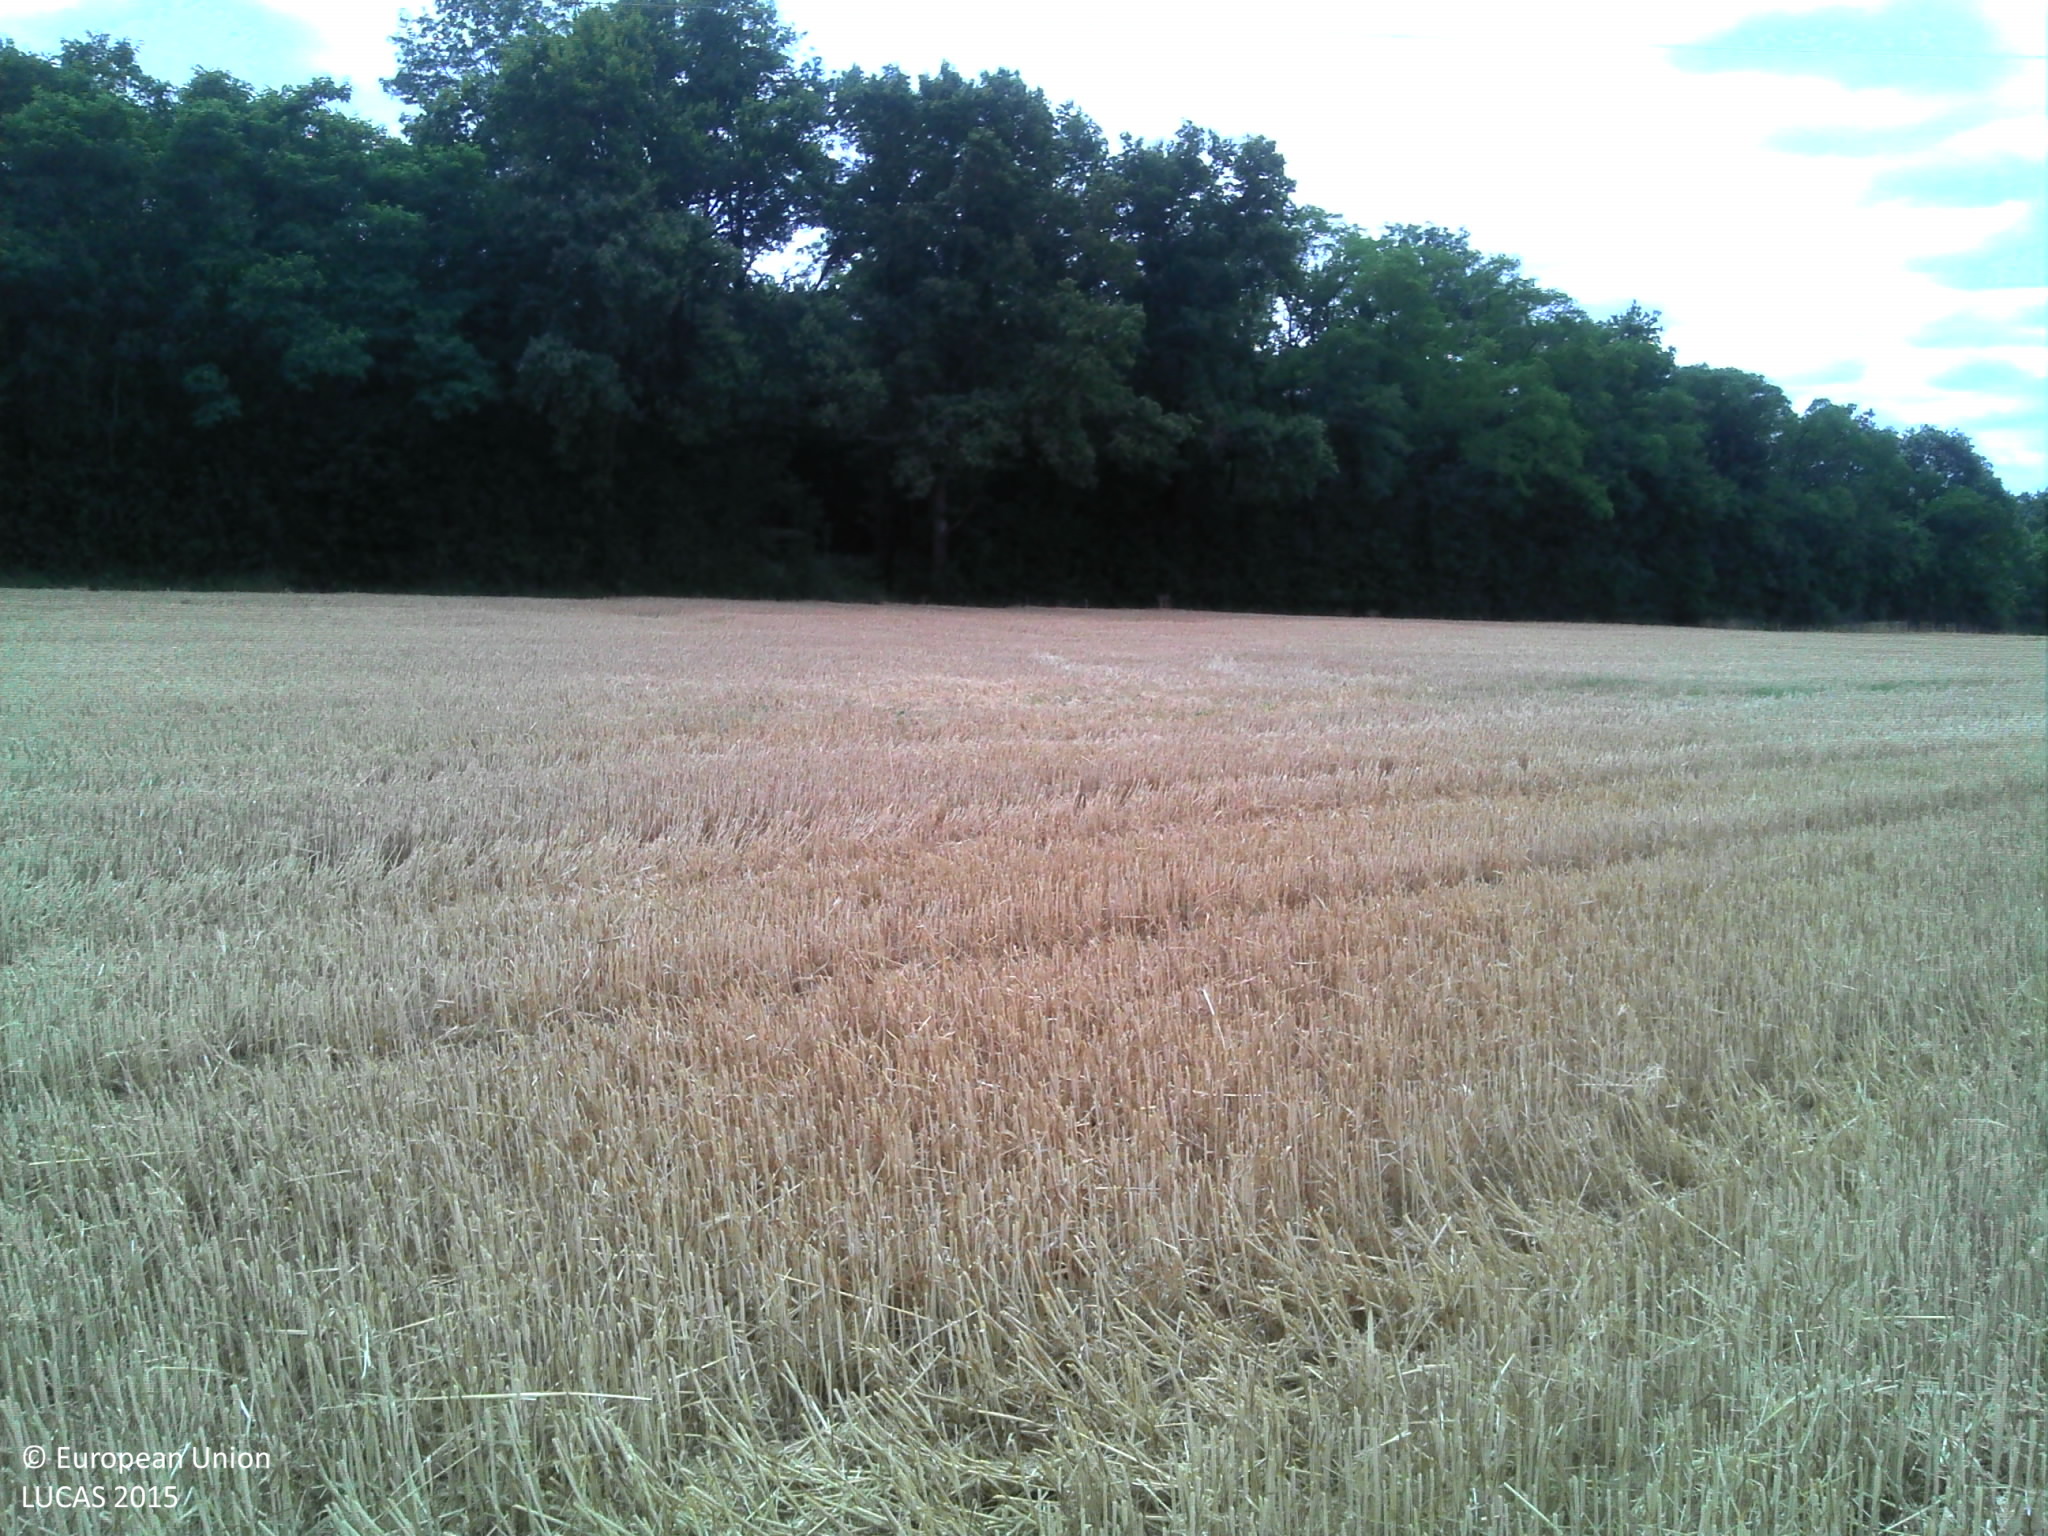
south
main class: Cropland
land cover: Common wheat
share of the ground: > 75 %
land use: Agriculture (excluding fallow land and kitchen gardens)
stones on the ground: 10 - 25 %
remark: Harvested field
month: July
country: FR
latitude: 47.7218
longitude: 3.4498
